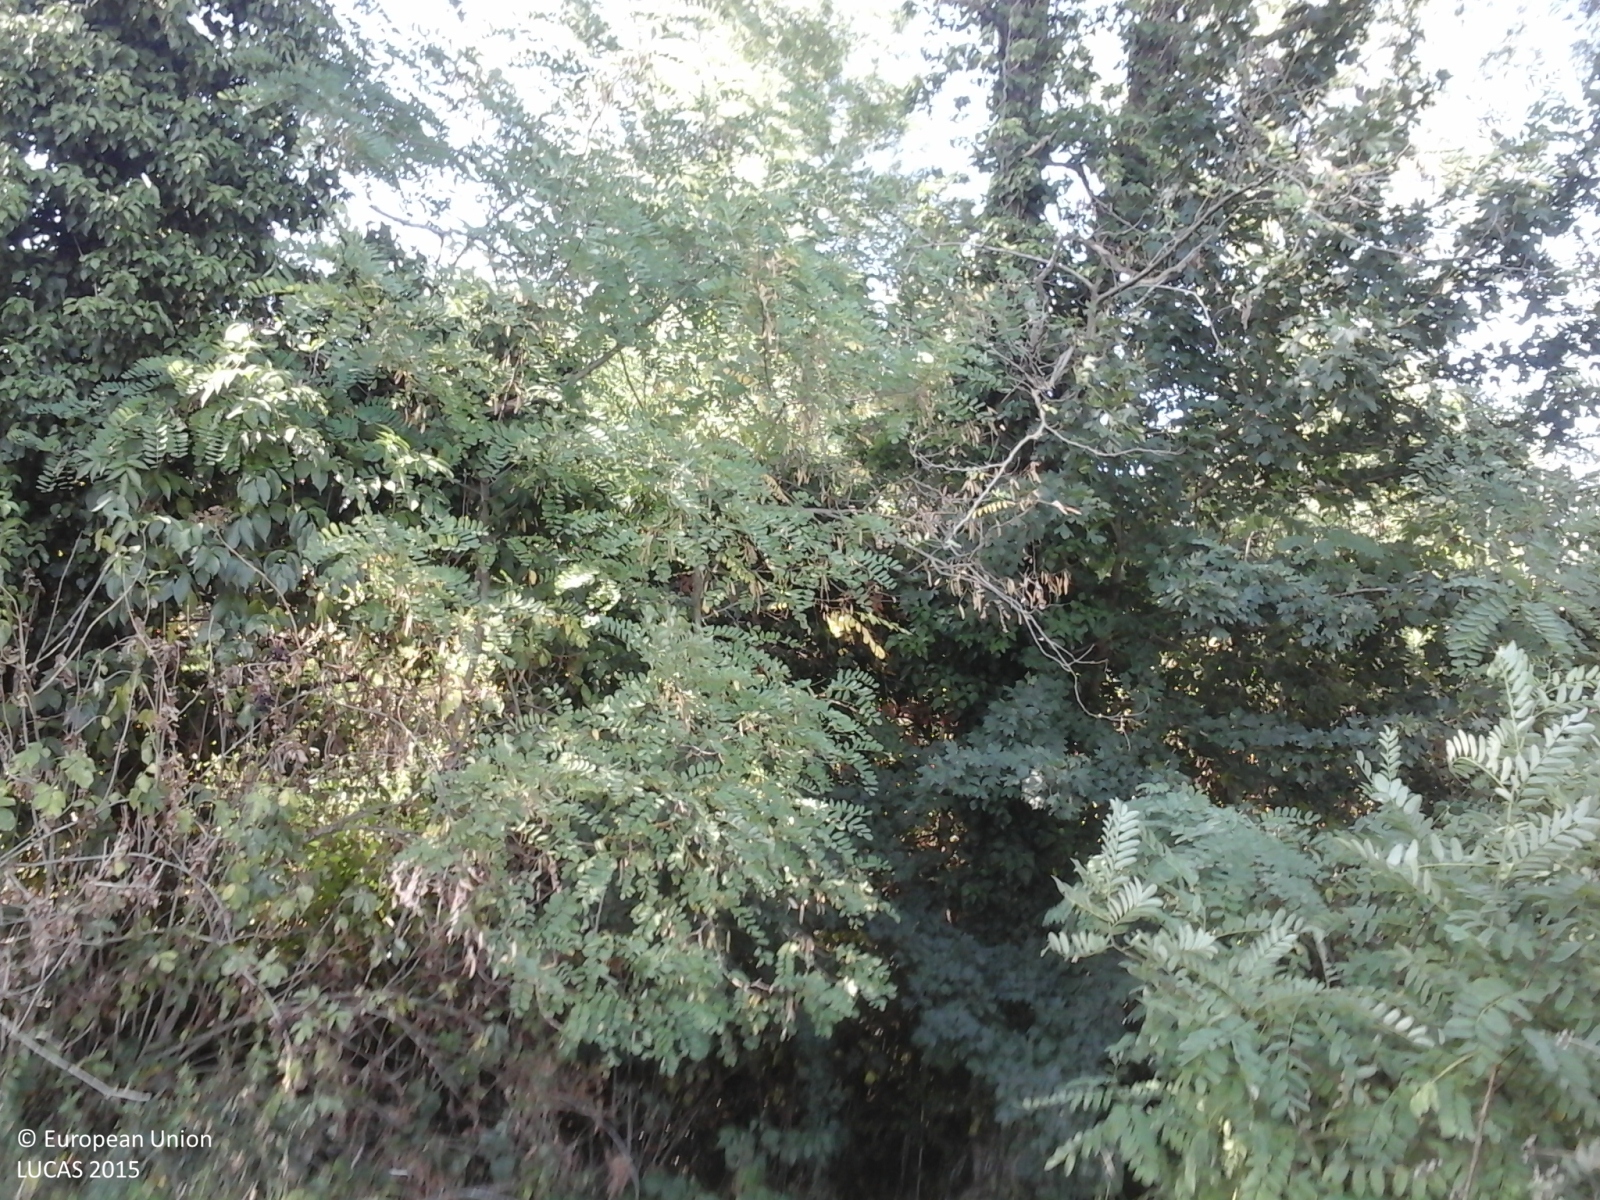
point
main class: Woodland
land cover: Broadleaved woodland
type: exotic forest
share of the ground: > 75 %
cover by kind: broadleaved forest trees 95 %, herbaceous plants 5 %
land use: Forestry
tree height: > 5 m
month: July
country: IT
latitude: 43.2687
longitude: 13.3056
